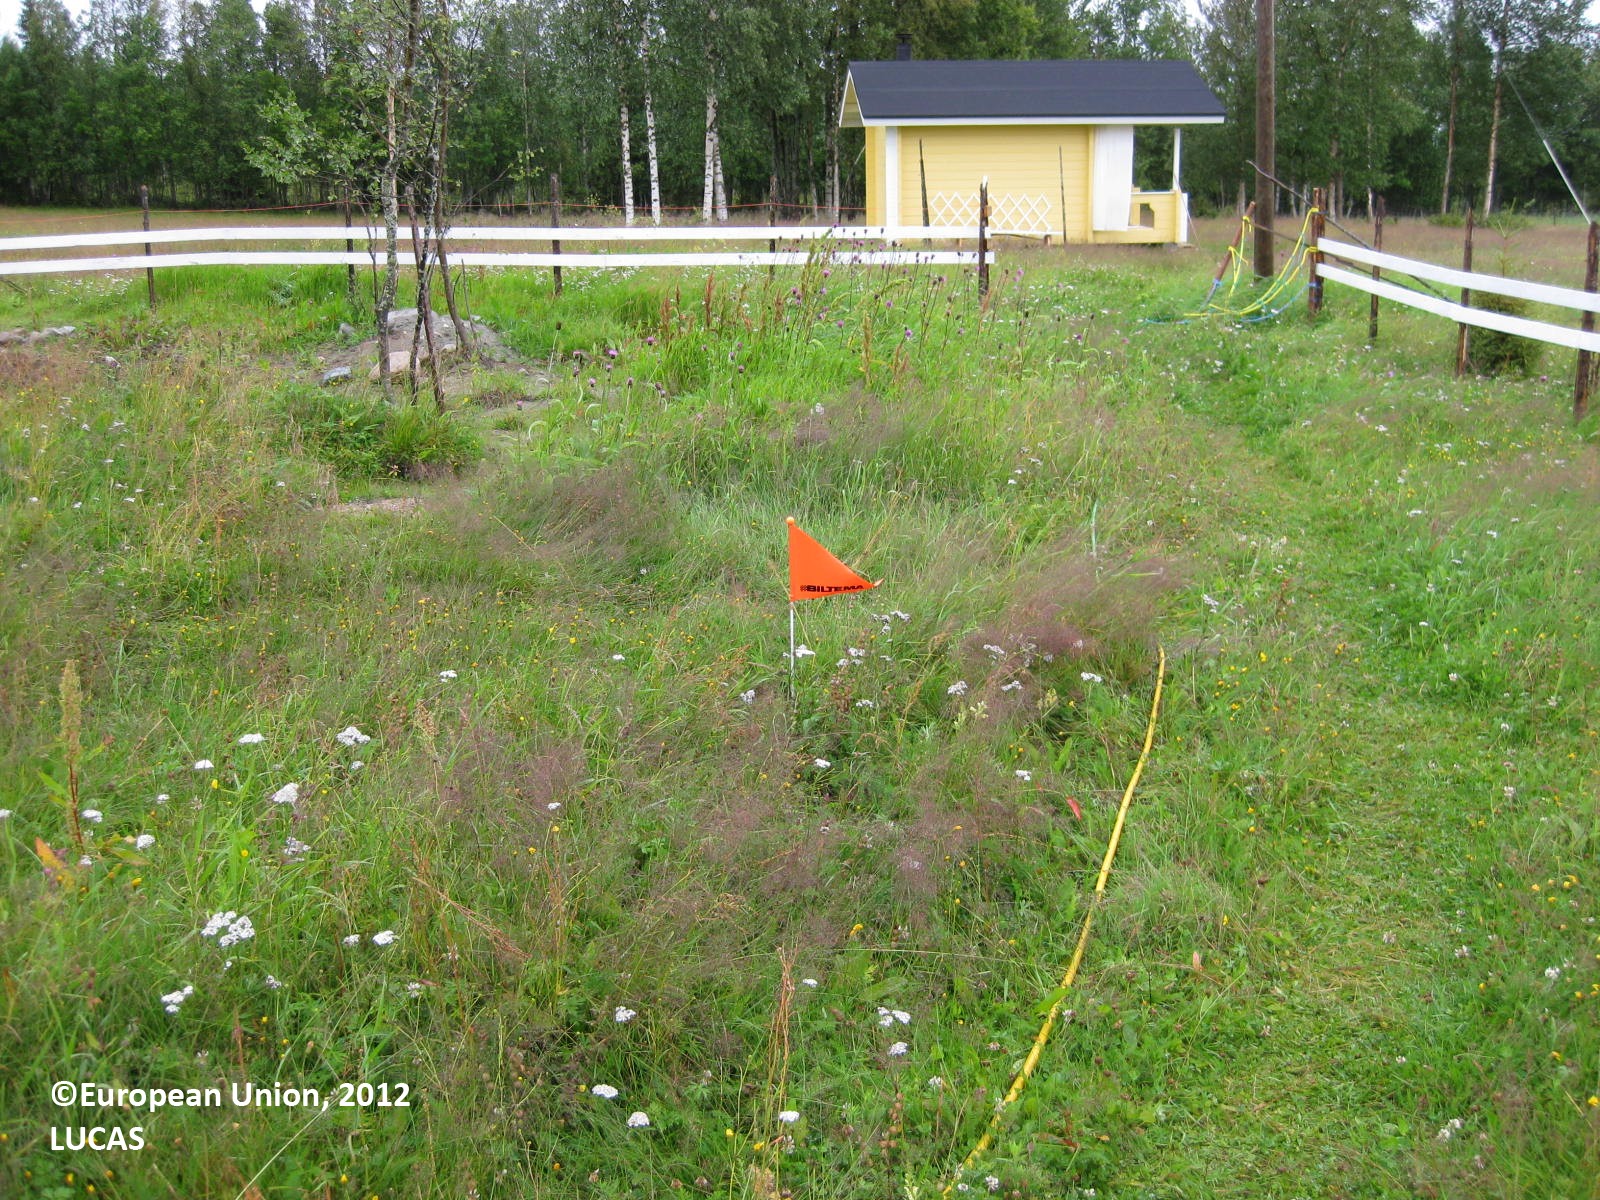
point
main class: Grassland
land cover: Grassland without tree/shrub cover
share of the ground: > 75 %
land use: Residential
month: August
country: FI
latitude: 65.9679
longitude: 28.1658
